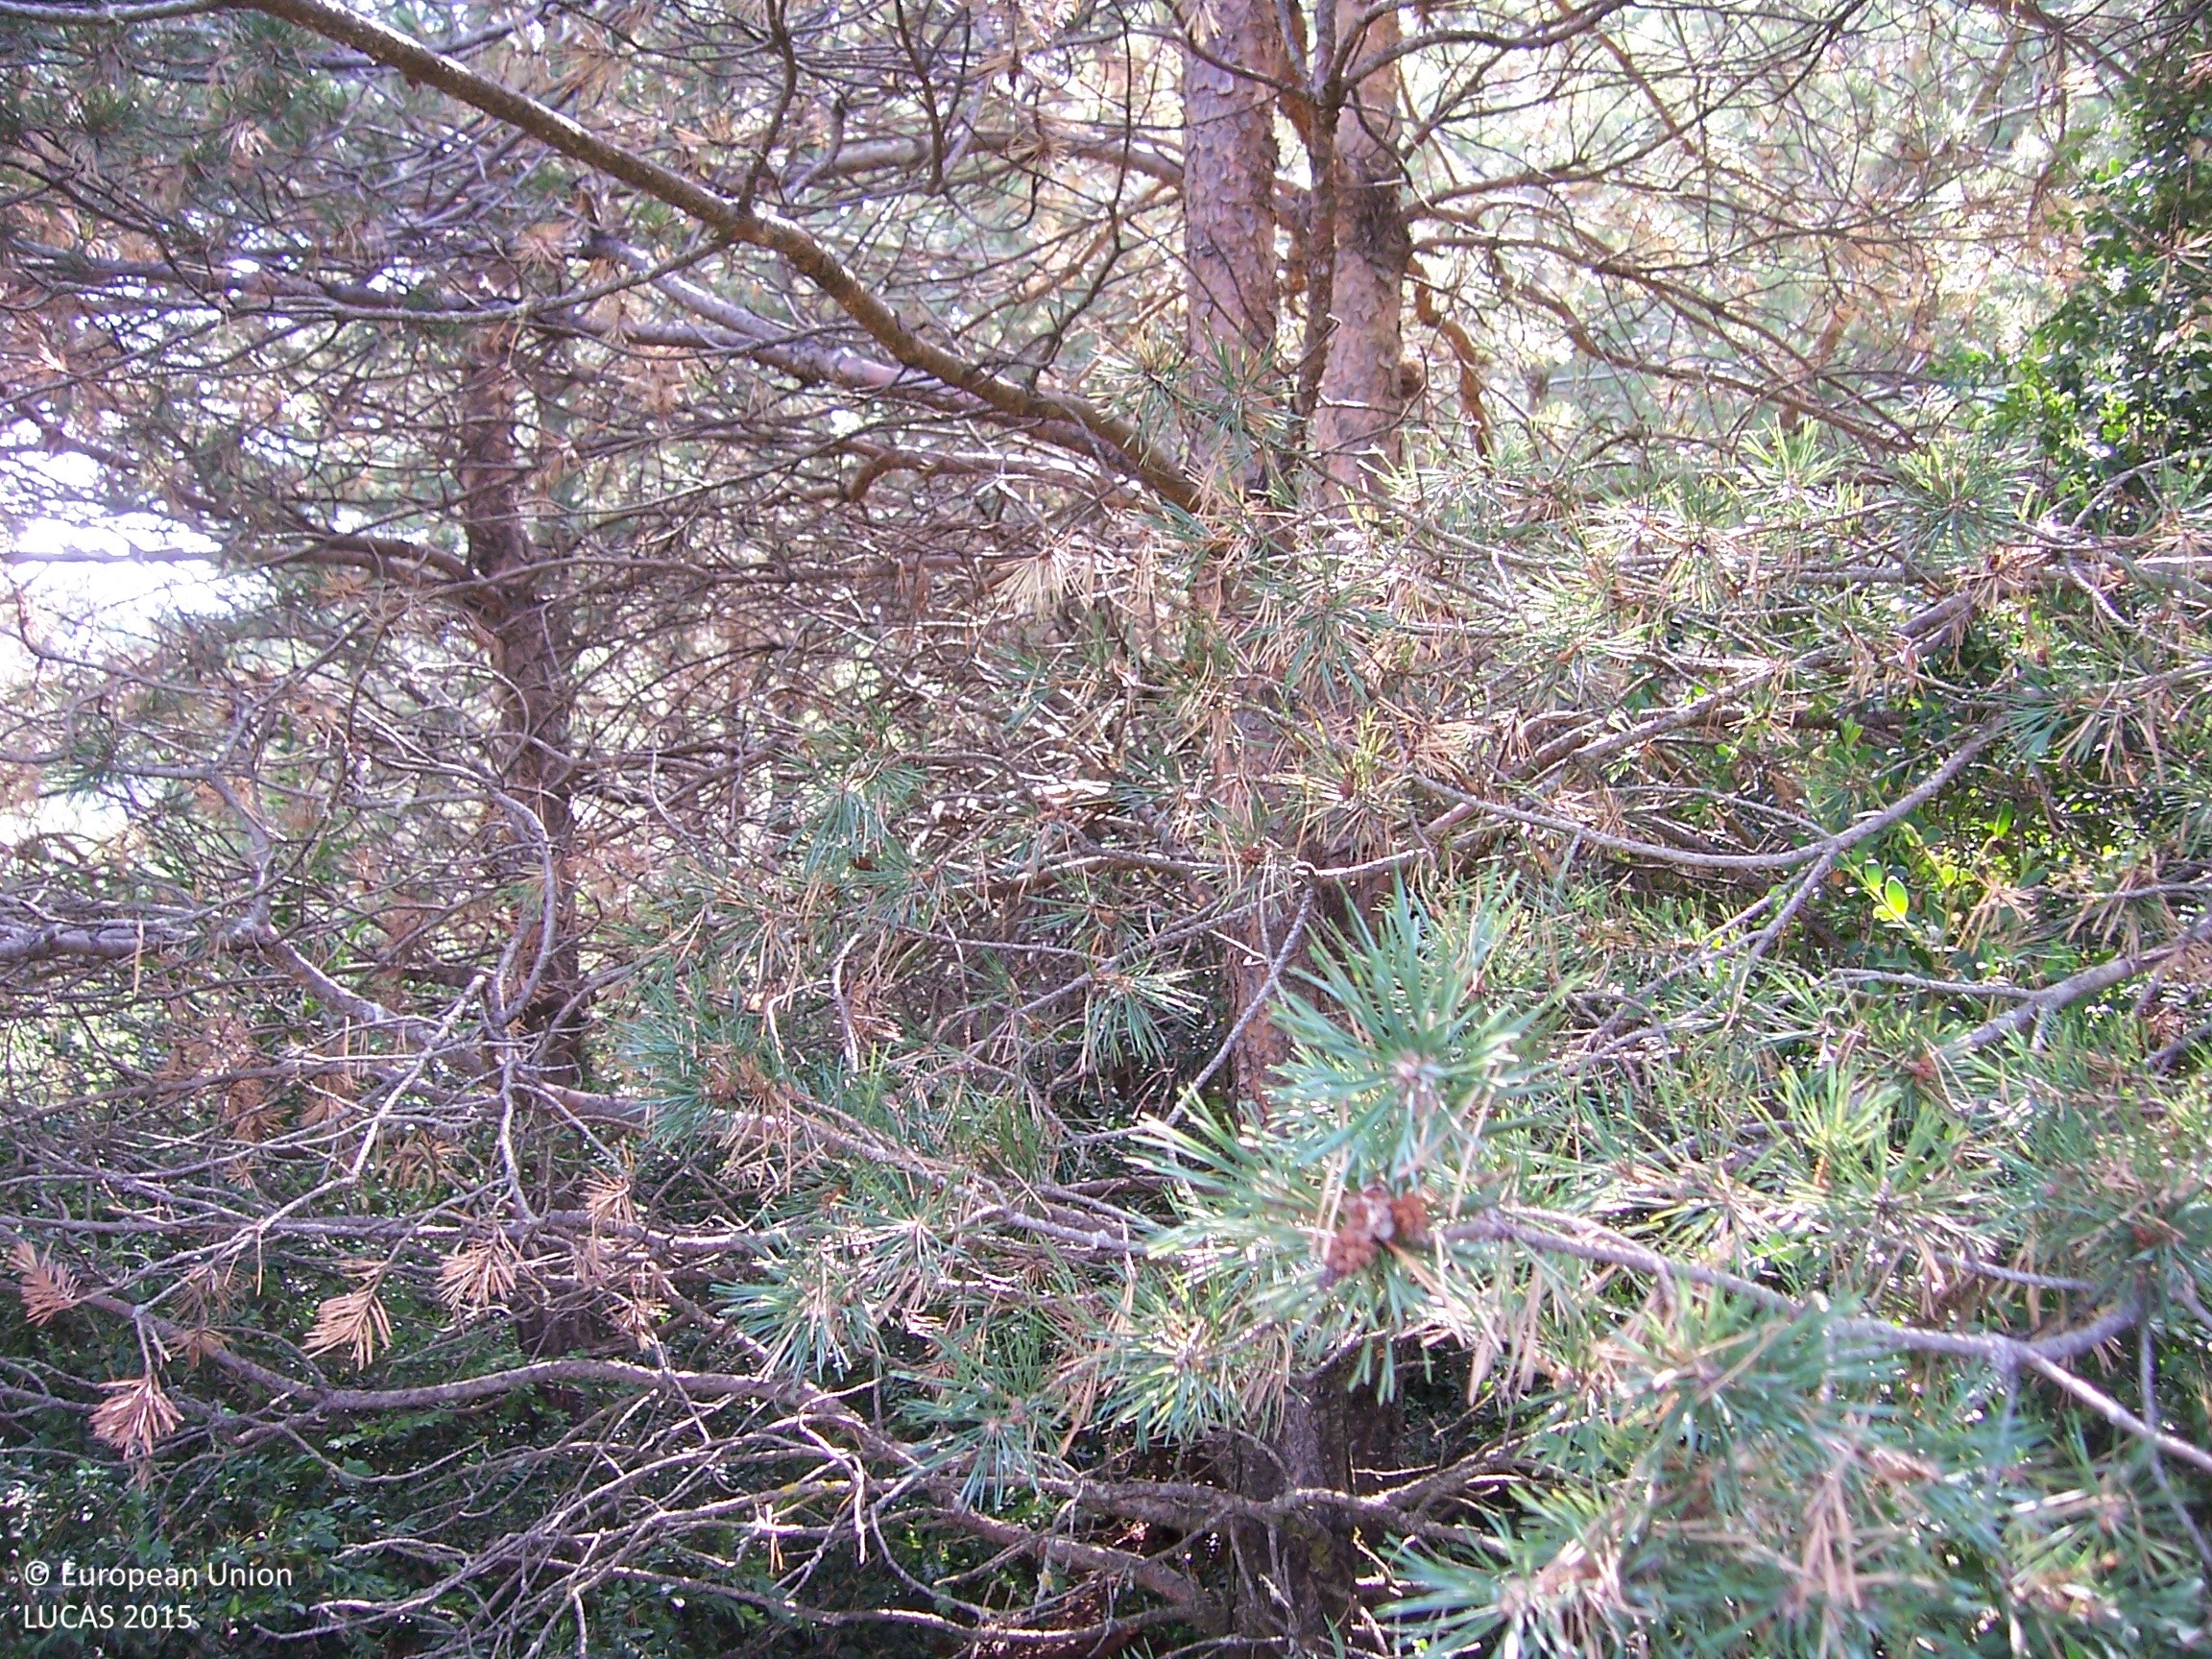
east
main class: Woodland
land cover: Pine dominated coniferous woodland
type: coniferous forest of the mediterranean region
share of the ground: > 75 %
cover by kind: coniferous forest trees 100 %
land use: Semi-natural and natural areas not in use
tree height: > 5 m
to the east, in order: Pine dominated coniferous woodland; Shrubland with sparse tree cover; Other bare soil
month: August
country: ES
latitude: 42.5652
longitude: -0.4658
